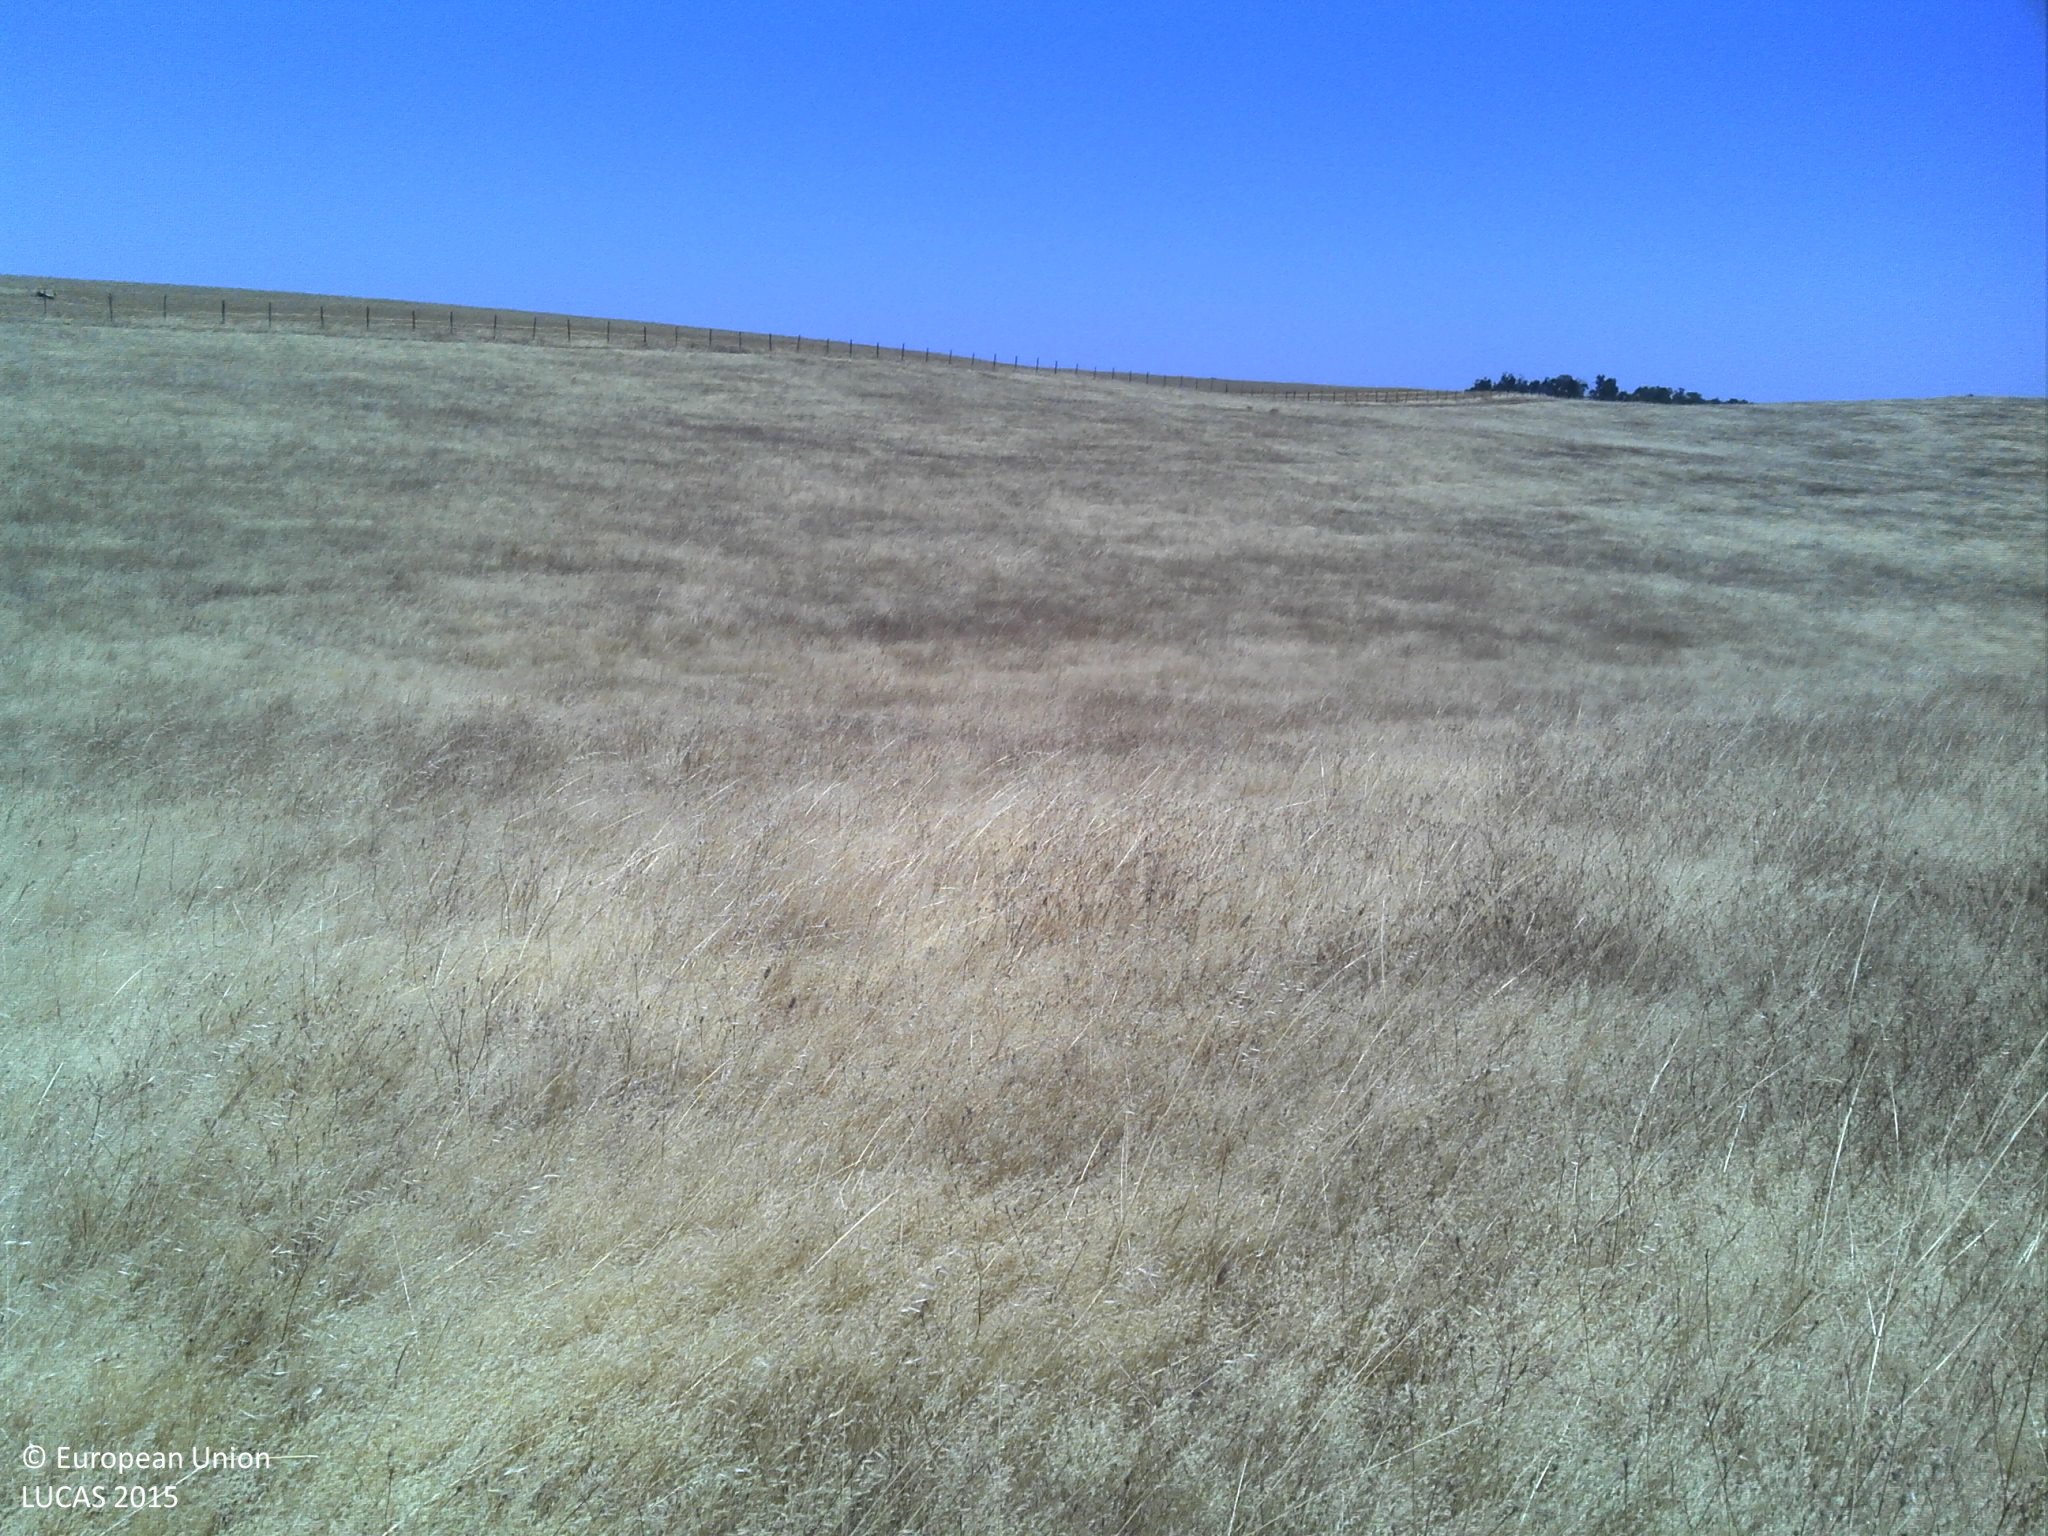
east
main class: Grassland
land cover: Grassland without tree/shrub cover
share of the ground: > 75 %
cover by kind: herbaceous plants 100 %
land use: Agriculture (excluding fallow land and kitchen gardens)
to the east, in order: Grassland without tree/shrub cover; Other bare soil; Grass margins; Fences; Other bare soil; Triticale
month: July
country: PT
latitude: 37.7912
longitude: -8.0027
